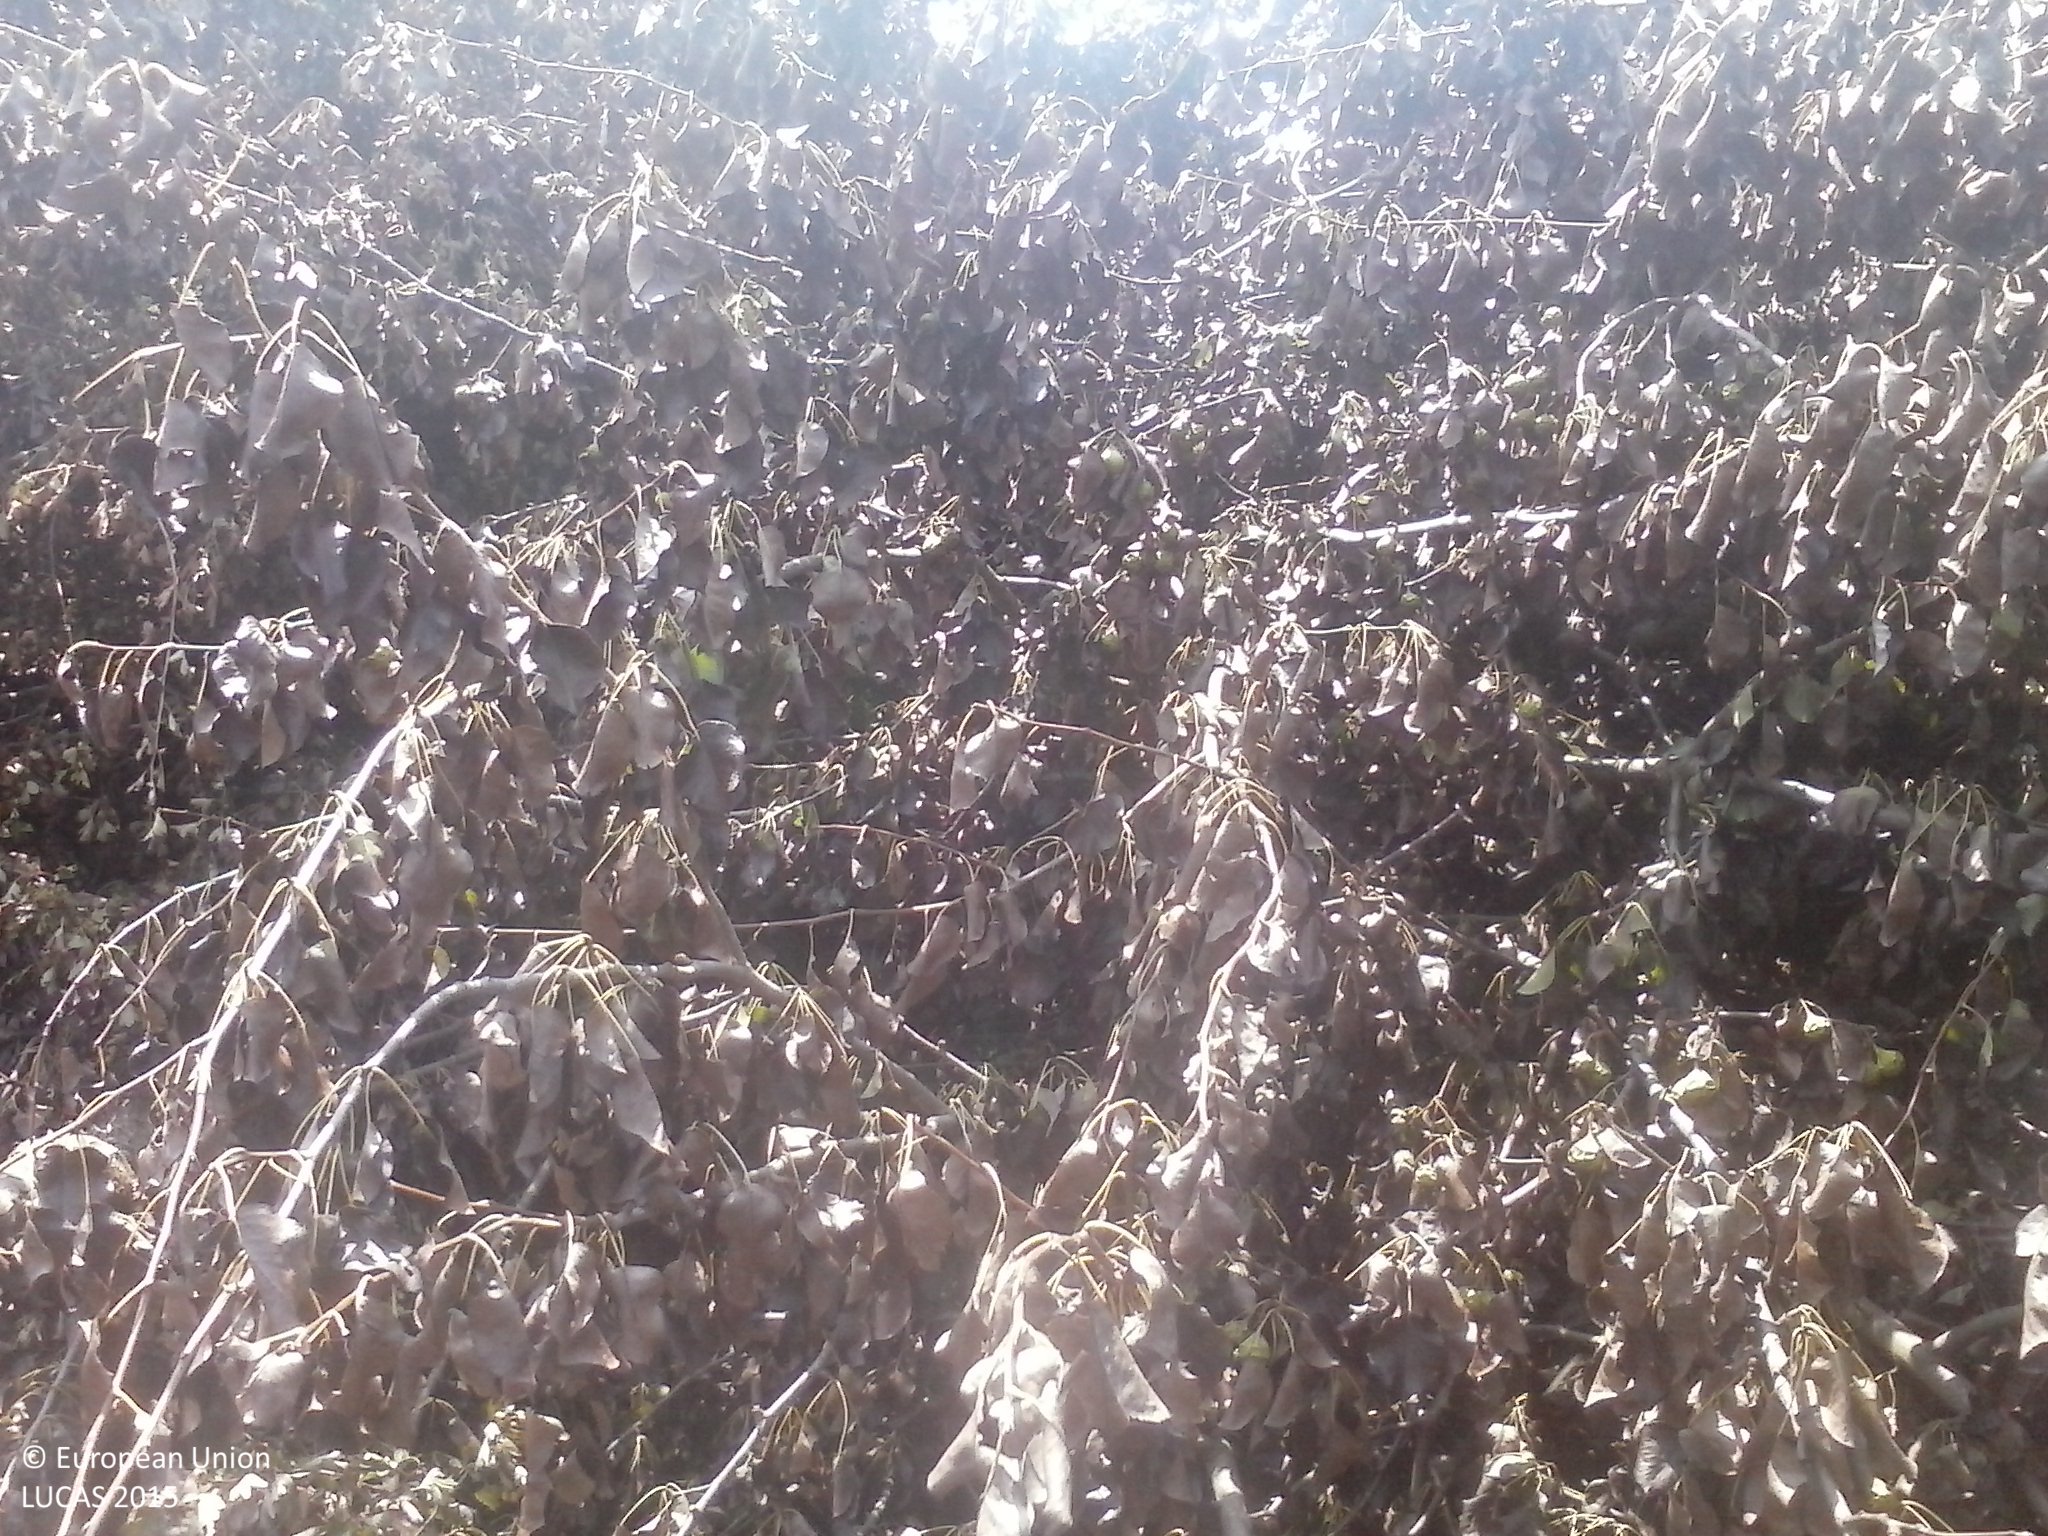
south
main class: Woodland
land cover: Broadleaved woodland
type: mesophytic deciduous forest
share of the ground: > 75 %
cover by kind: broadleaved forest trees 90 %, shrubs 5 %, herbaceous plants 5 %
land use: Forestry
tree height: < 5 m
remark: Clear cut
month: August
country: HU
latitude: 45.9210
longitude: 17.8053
